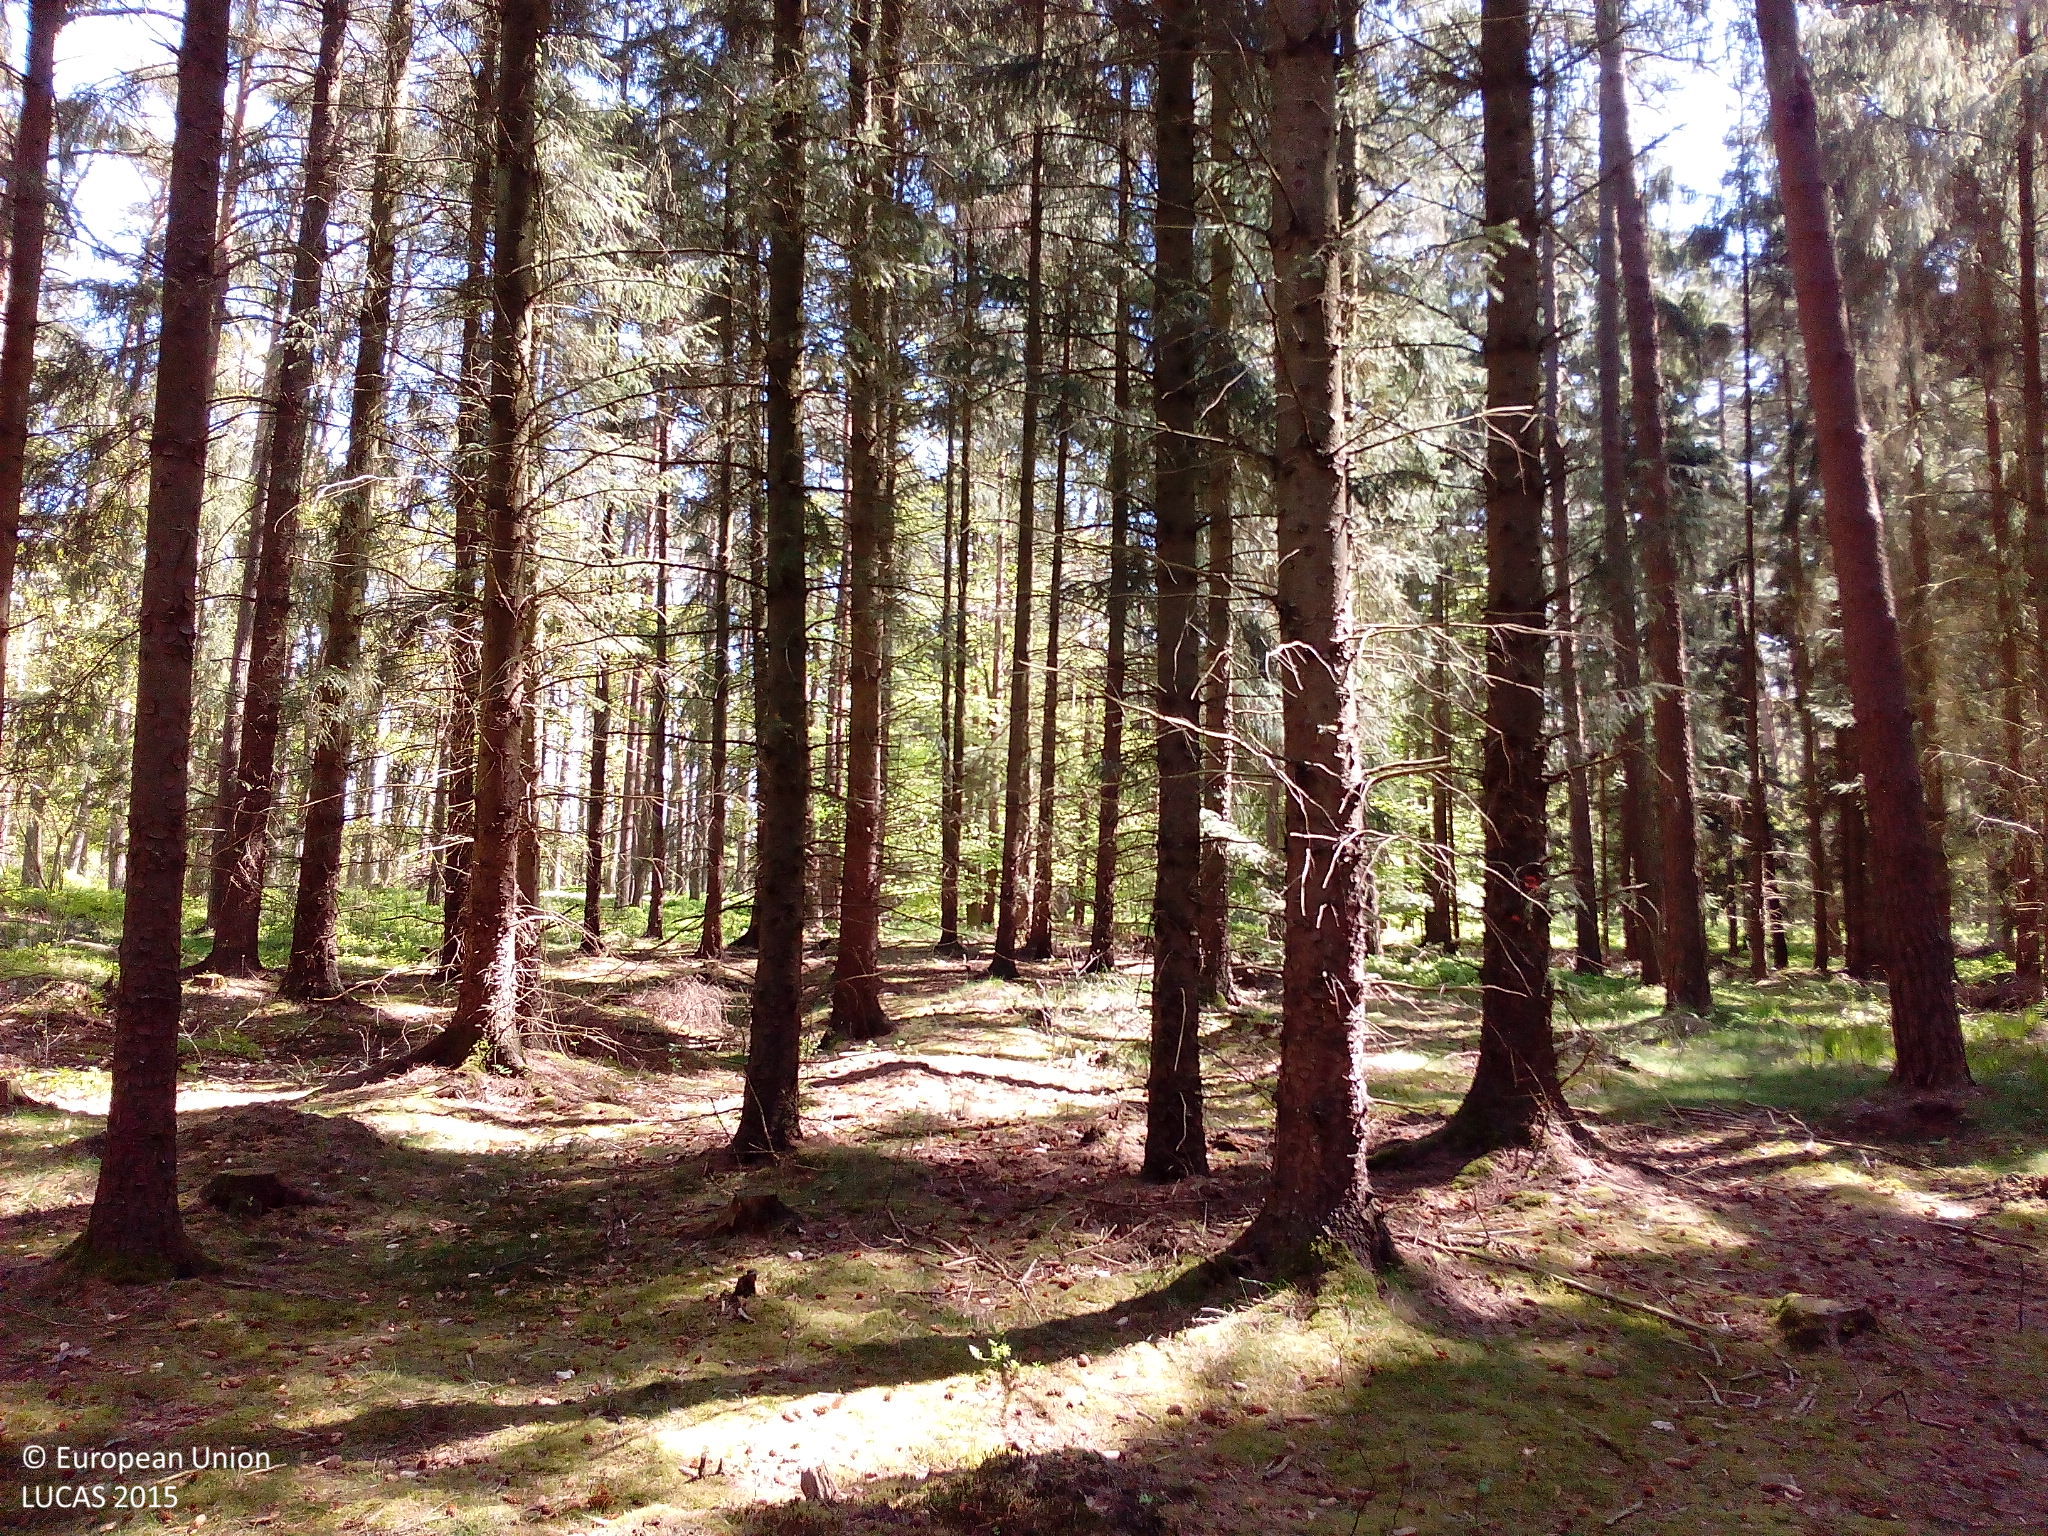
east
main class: Woodland
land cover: Other coniferous woodland
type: mesophytic deciduous forest
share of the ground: > 75 %
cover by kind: coniferous forest trees 75 %, broadleaved forest trees 20 %, lichens and mosses 5 %
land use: Forestry
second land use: Amenities, museums, leisure
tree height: > 5 m
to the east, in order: Other coniferous woodland; Pine dominated coniferous woodland; Other coniferous woodland
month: May
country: DE
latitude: 54.3624
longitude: 12.6306
